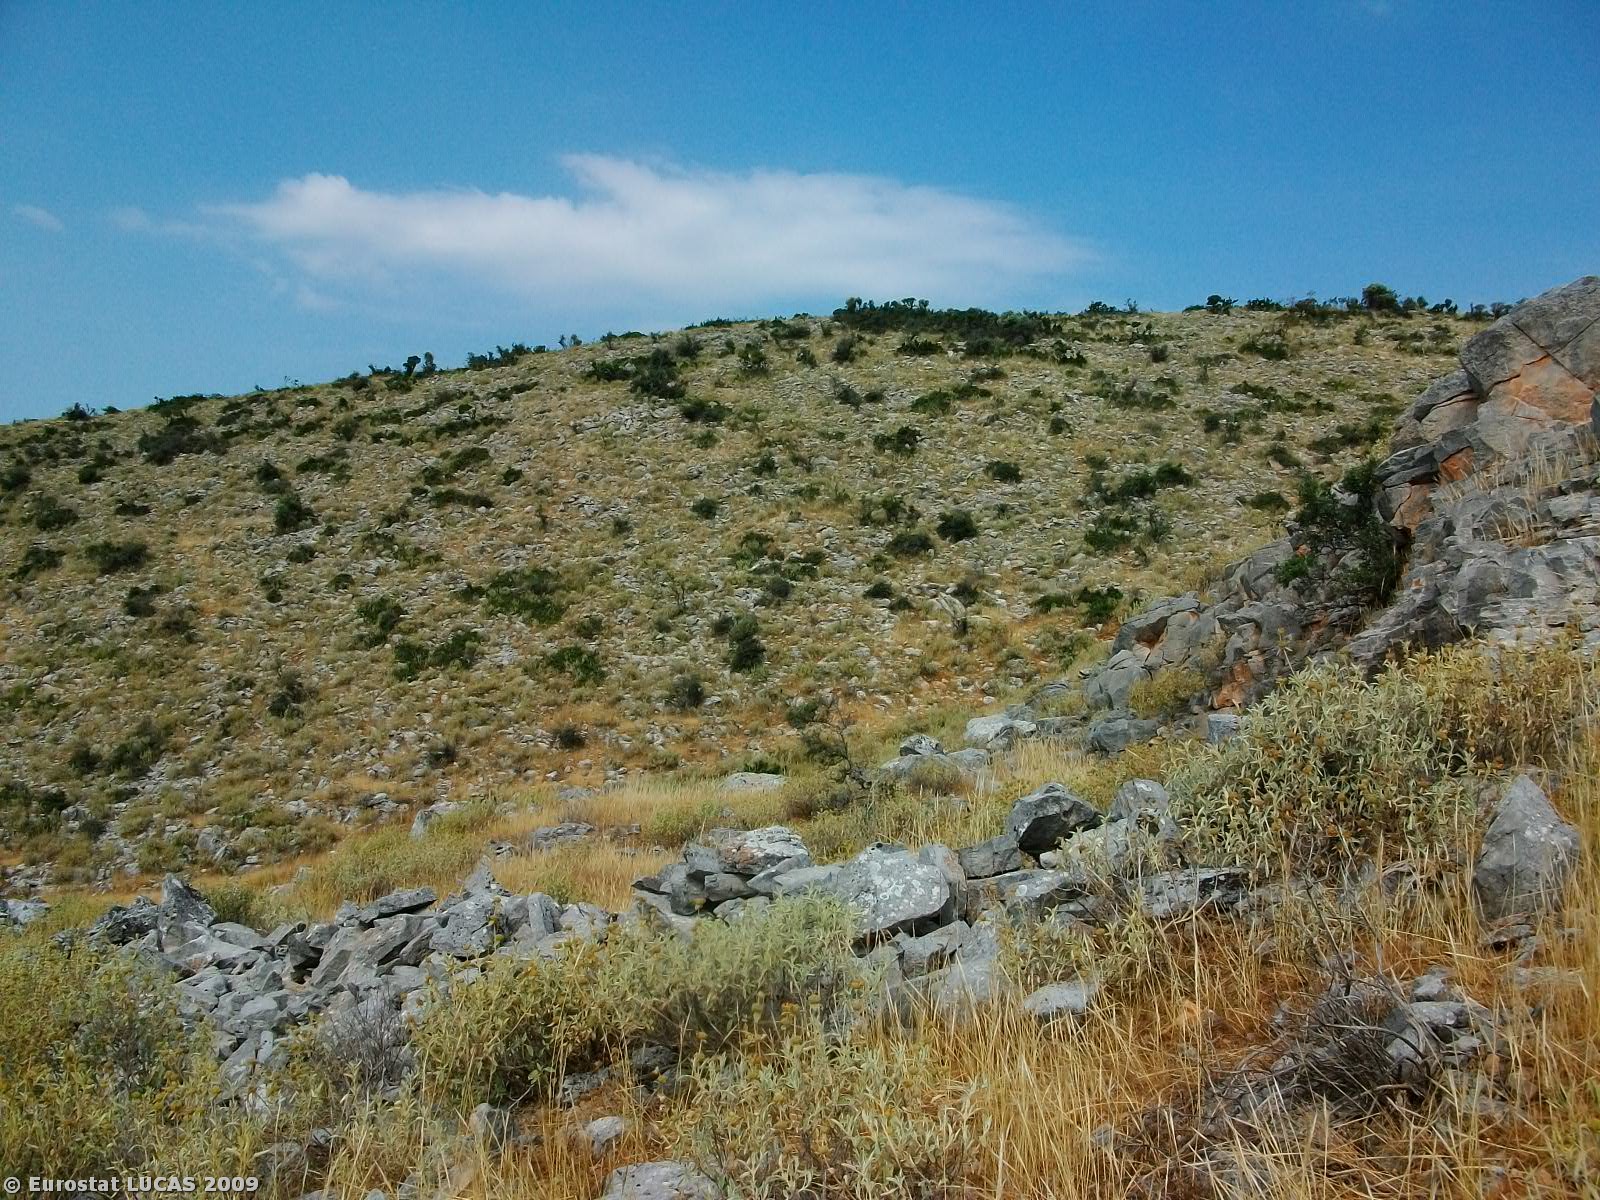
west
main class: Shrubland
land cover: Shrubland without tree cover
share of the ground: 50 - 75 %
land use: Agriculture (excluding fallow land and kitchen gardens)
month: May
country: GR
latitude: 39.4068
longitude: 22.8002
